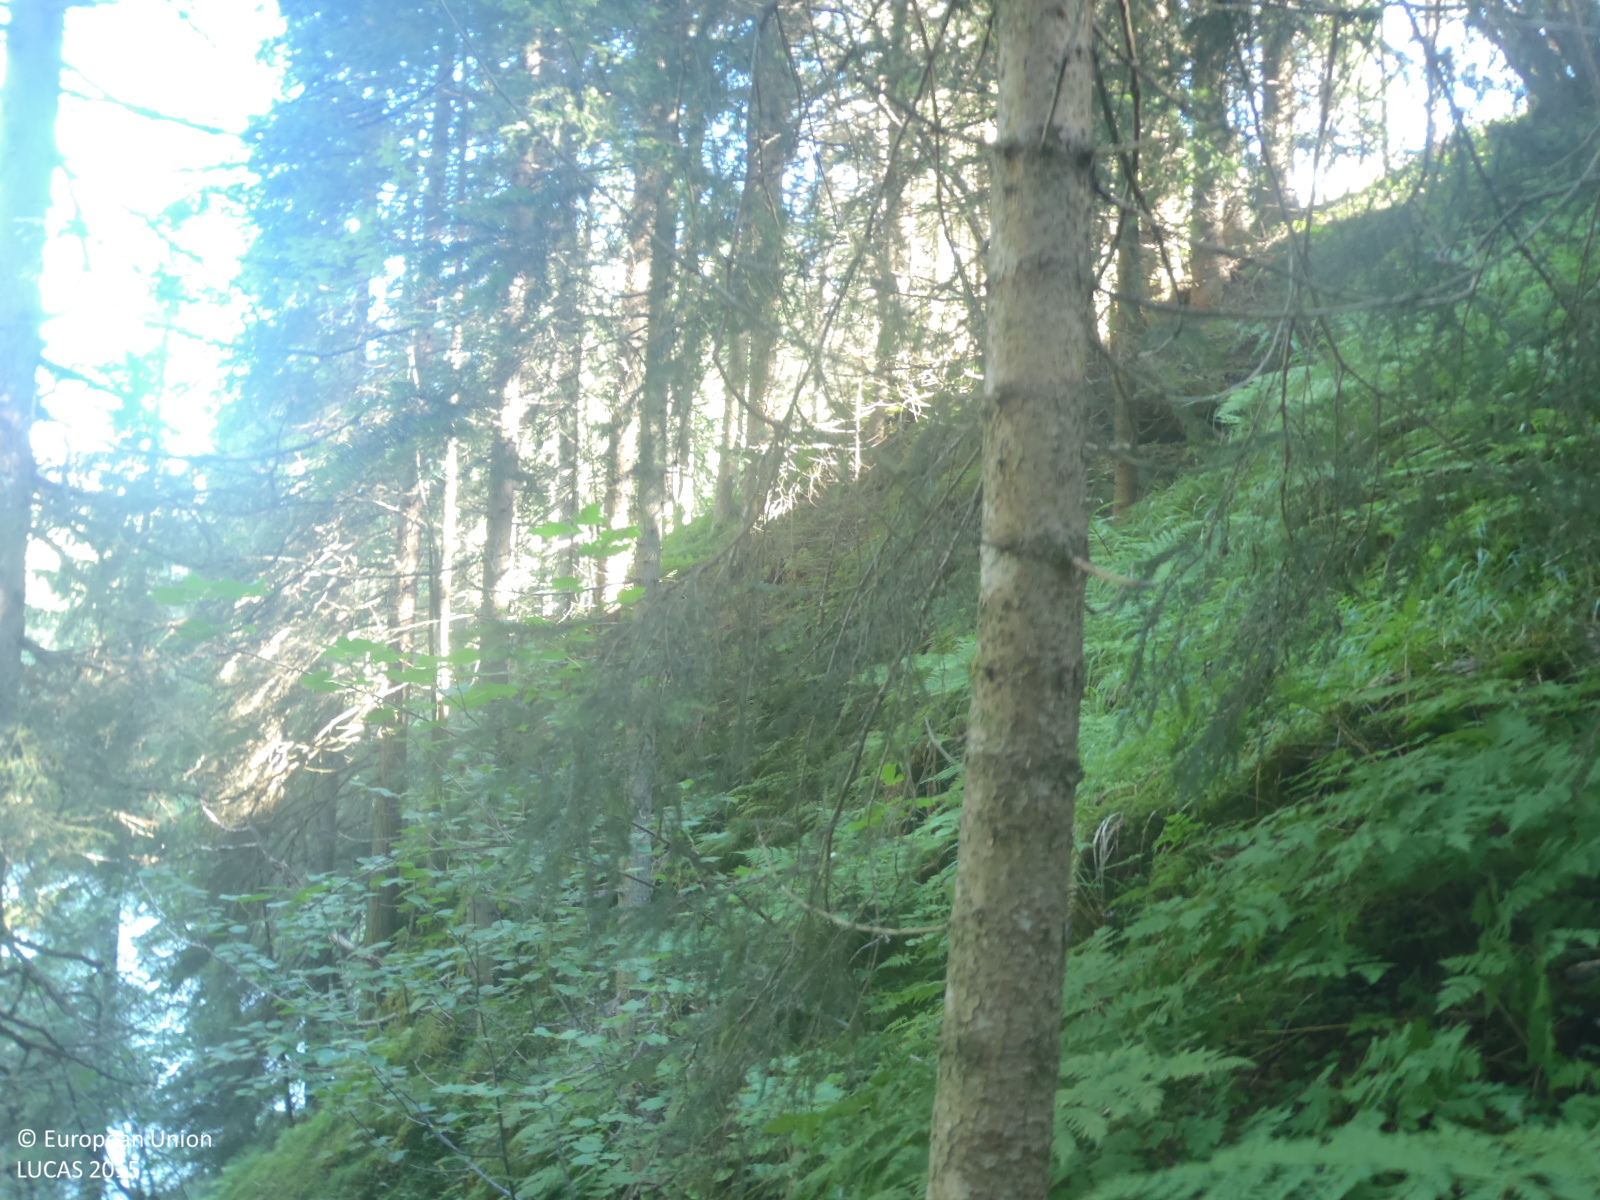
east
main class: Woodland
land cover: Spruce dominated coniferous woodland
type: alpine coniferous forest
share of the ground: > 75 %
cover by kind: coniferous forest trees 95 %, broadleaved forest trees 5 %
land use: Forestry
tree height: > 5 m
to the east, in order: Spruce dominated coniferous woodland; Shrubland with sparse tree cover; Spruce dominated coniferous woodland; Shrubland with sparse tree cover; Inland fresh running water; Spruce dominated coniferous woodland; Fences; Shrubland without tree cover; Grassland without tree/shrub cover; Electric lines; Grassland without tree/shrub cover; Shrubland without tree cover; Grassland without tree/shrub cover; Electric lines; Tracks; Grassland without tree/shrub cover; Inland marshes; Fences; Other mixed woodland; Grassland without tree/shrub cover
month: August
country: AT
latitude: 47.0964
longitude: 12.5143
